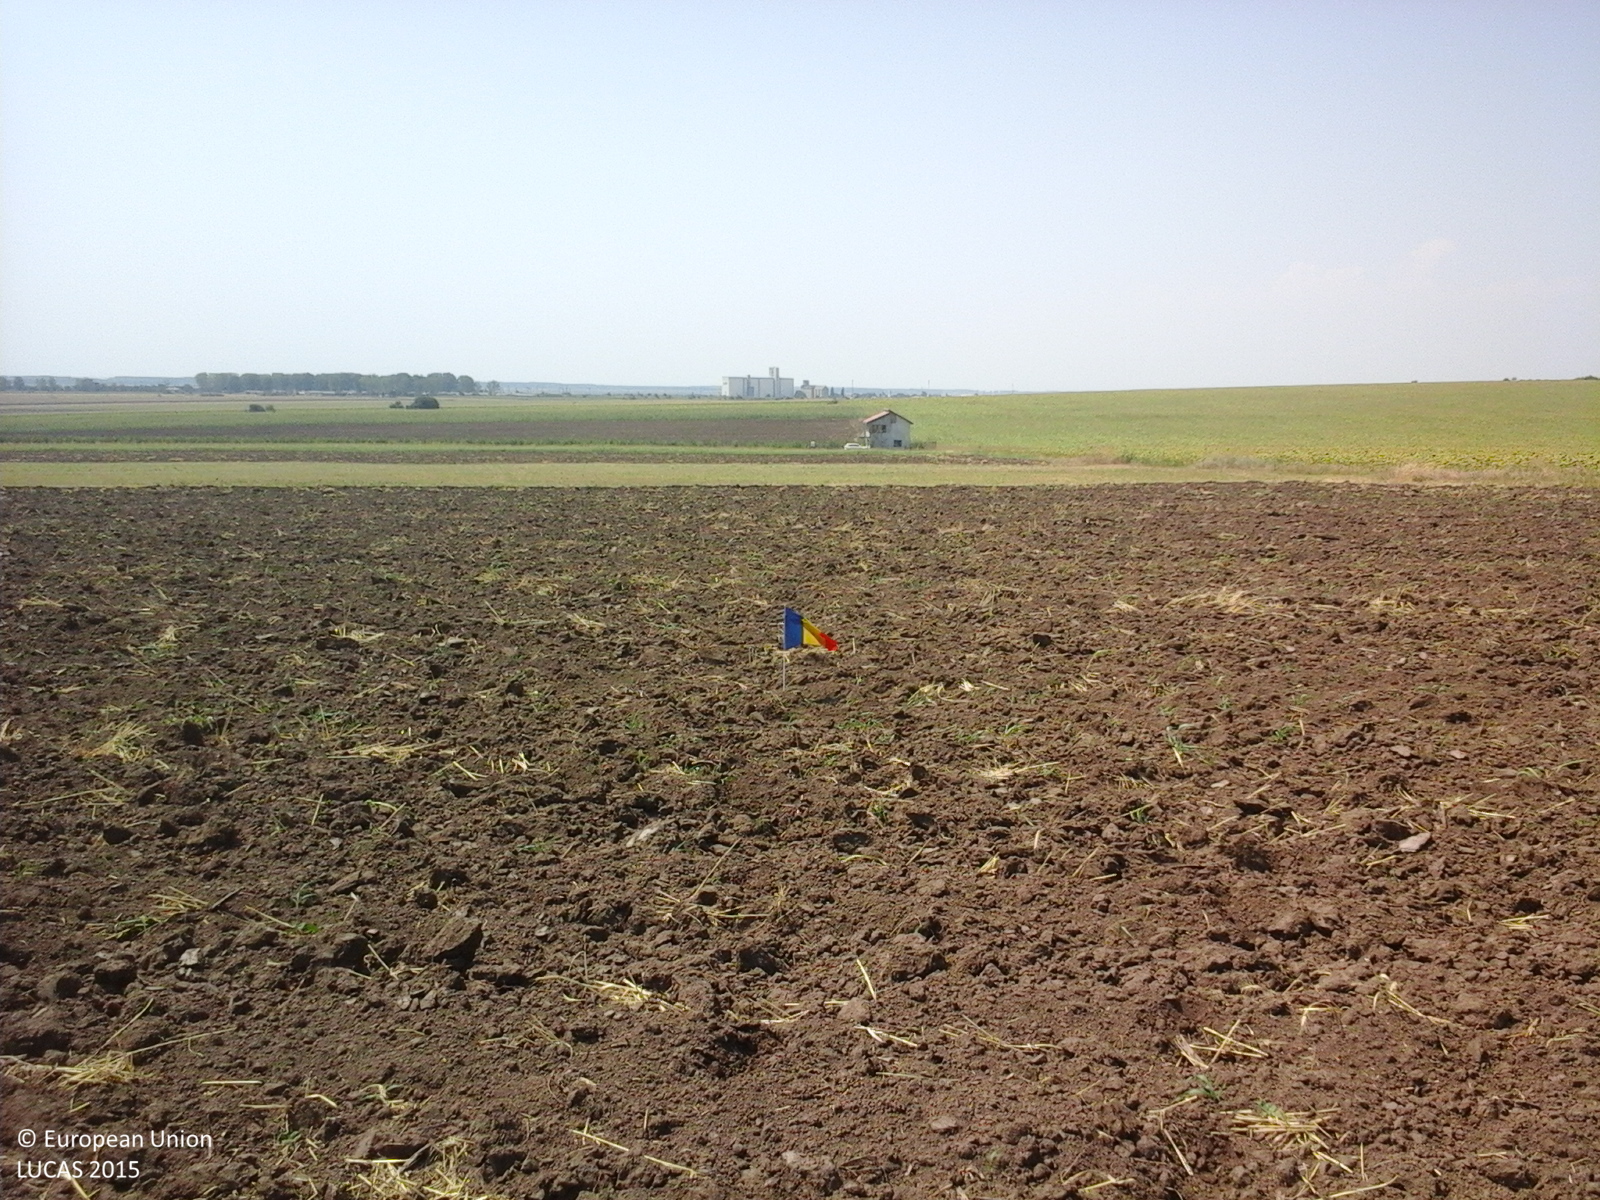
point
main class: Cropland
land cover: Common wheat
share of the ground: < 10 %
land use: Agriculture (excluding fallow land and kitchen gardens)
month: July
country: RO
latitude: 45.4690
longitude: 27.8006
